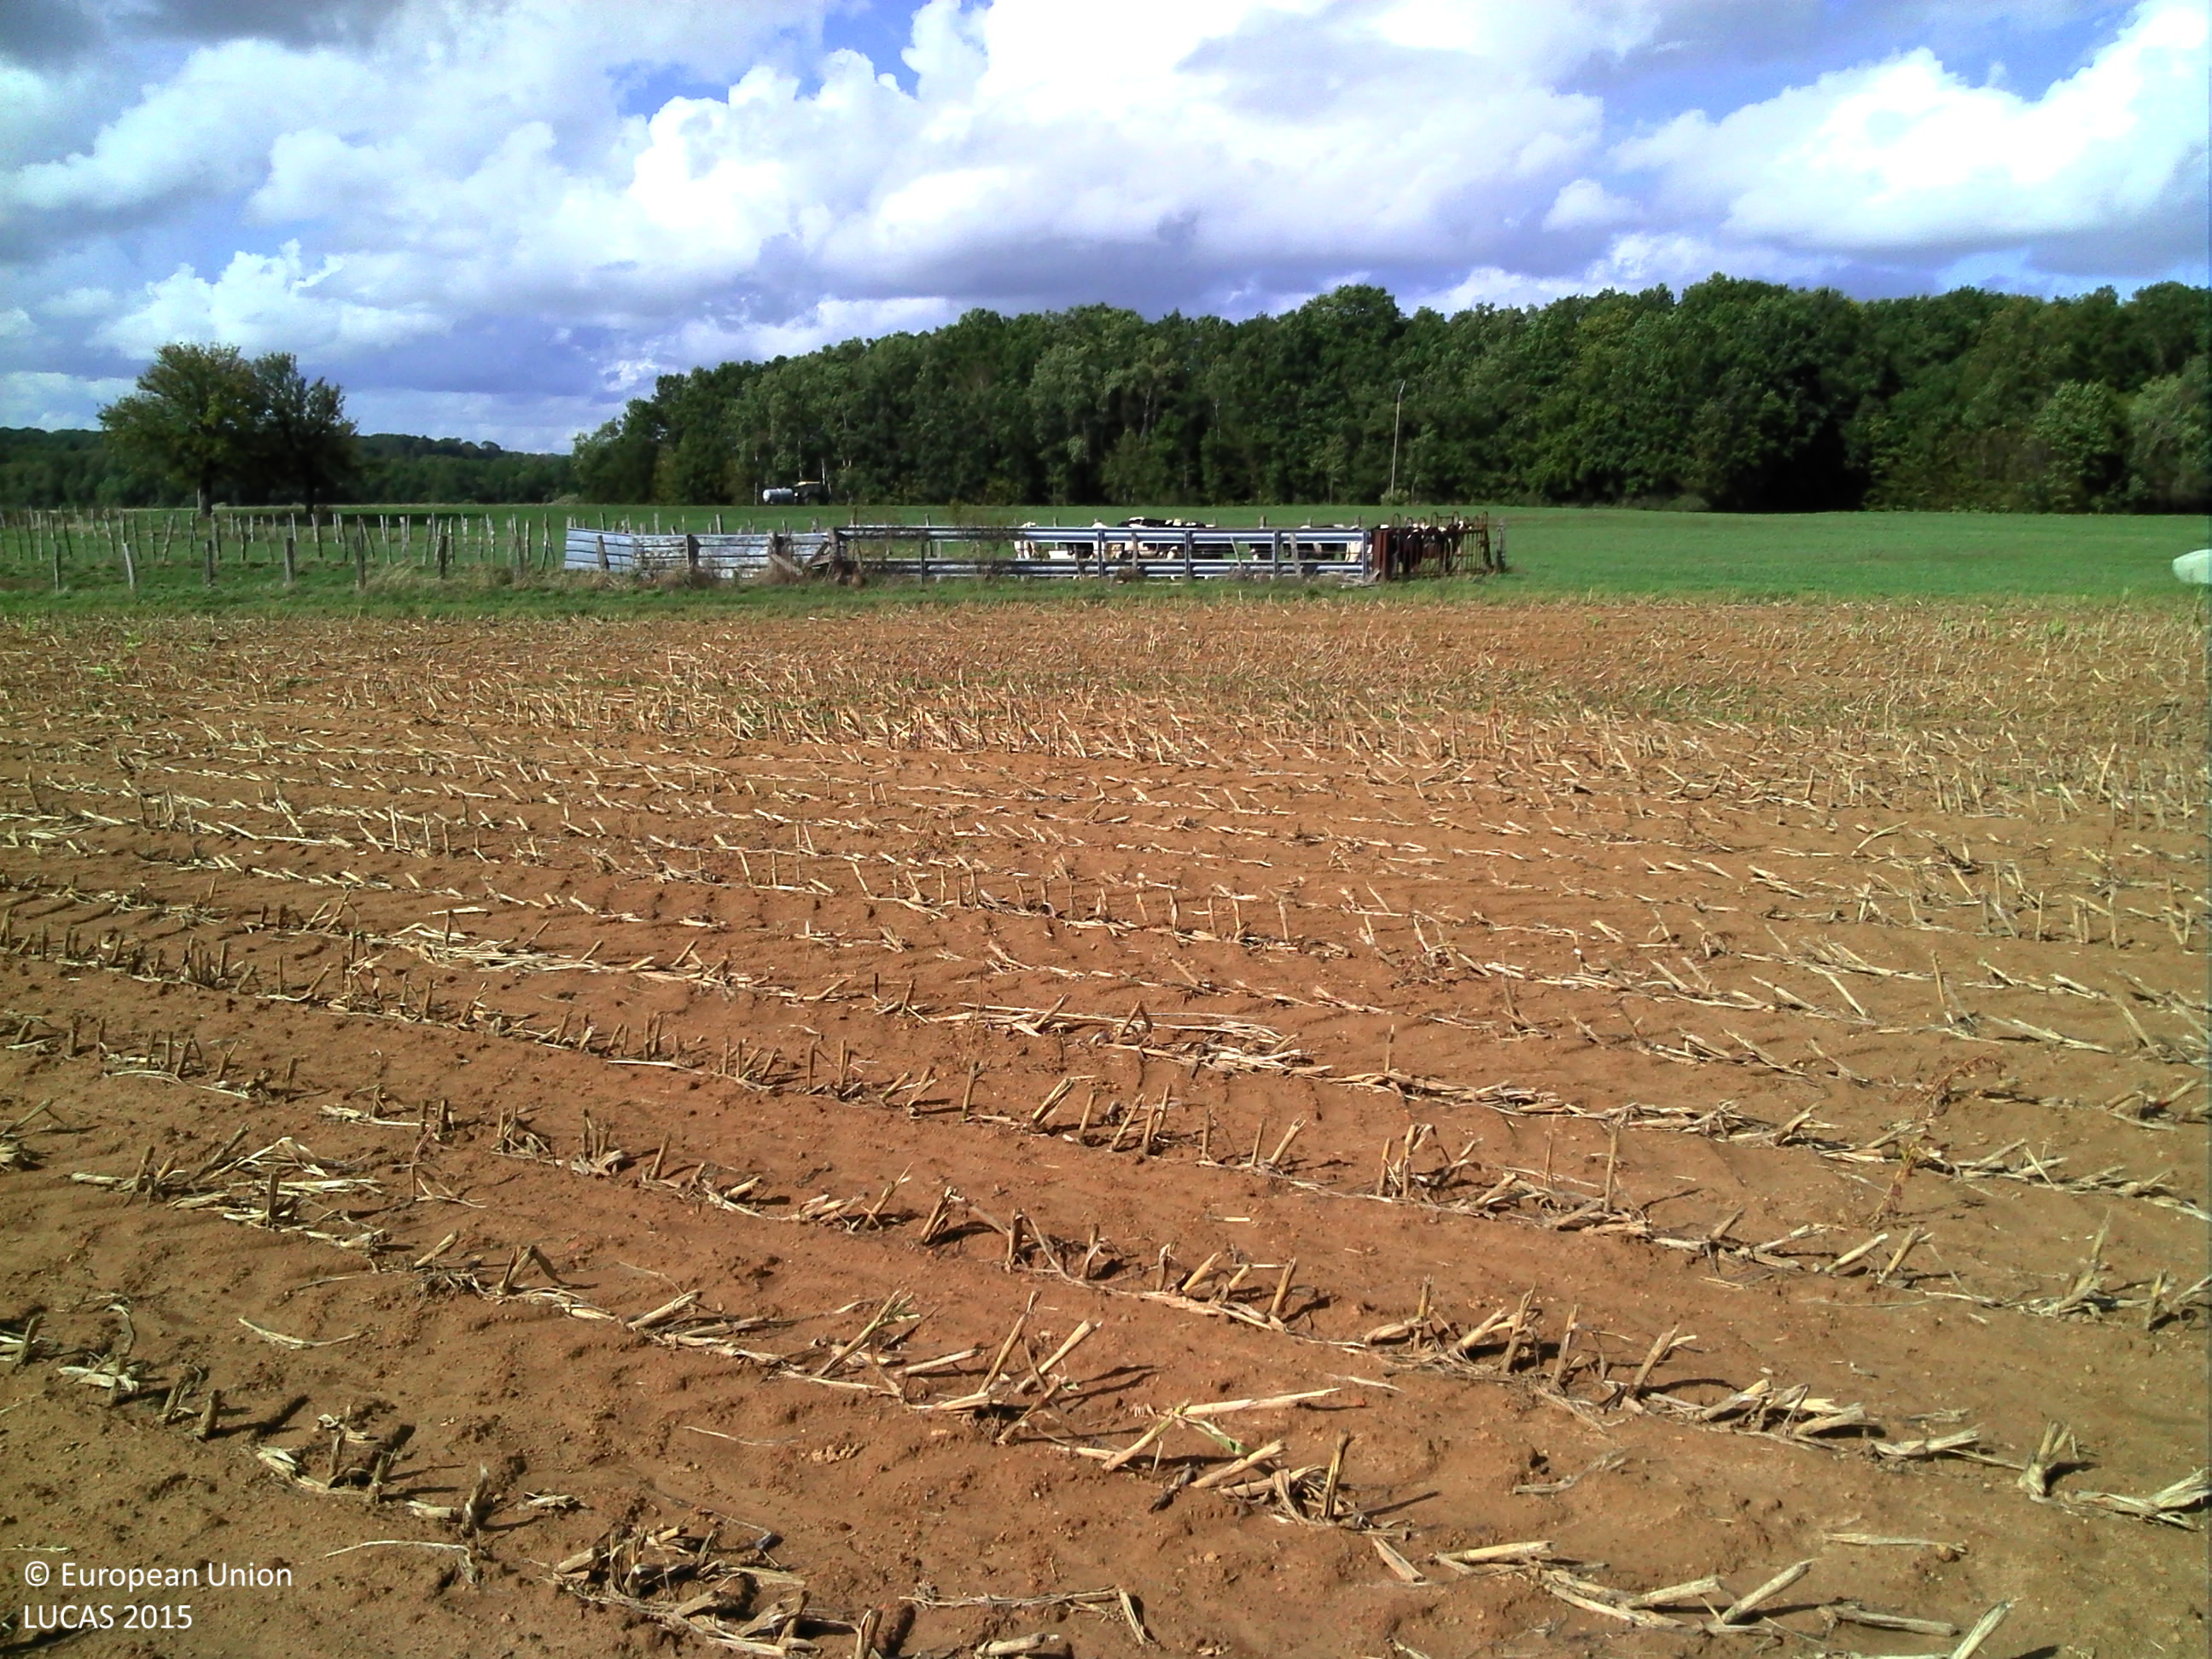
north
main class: Cropland
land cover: Maize
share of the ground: < 10 %
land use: Agriculture (excluding fallow land and kitchen gardens)
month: September
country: FR
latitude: 48.3675
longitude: 4.7200
